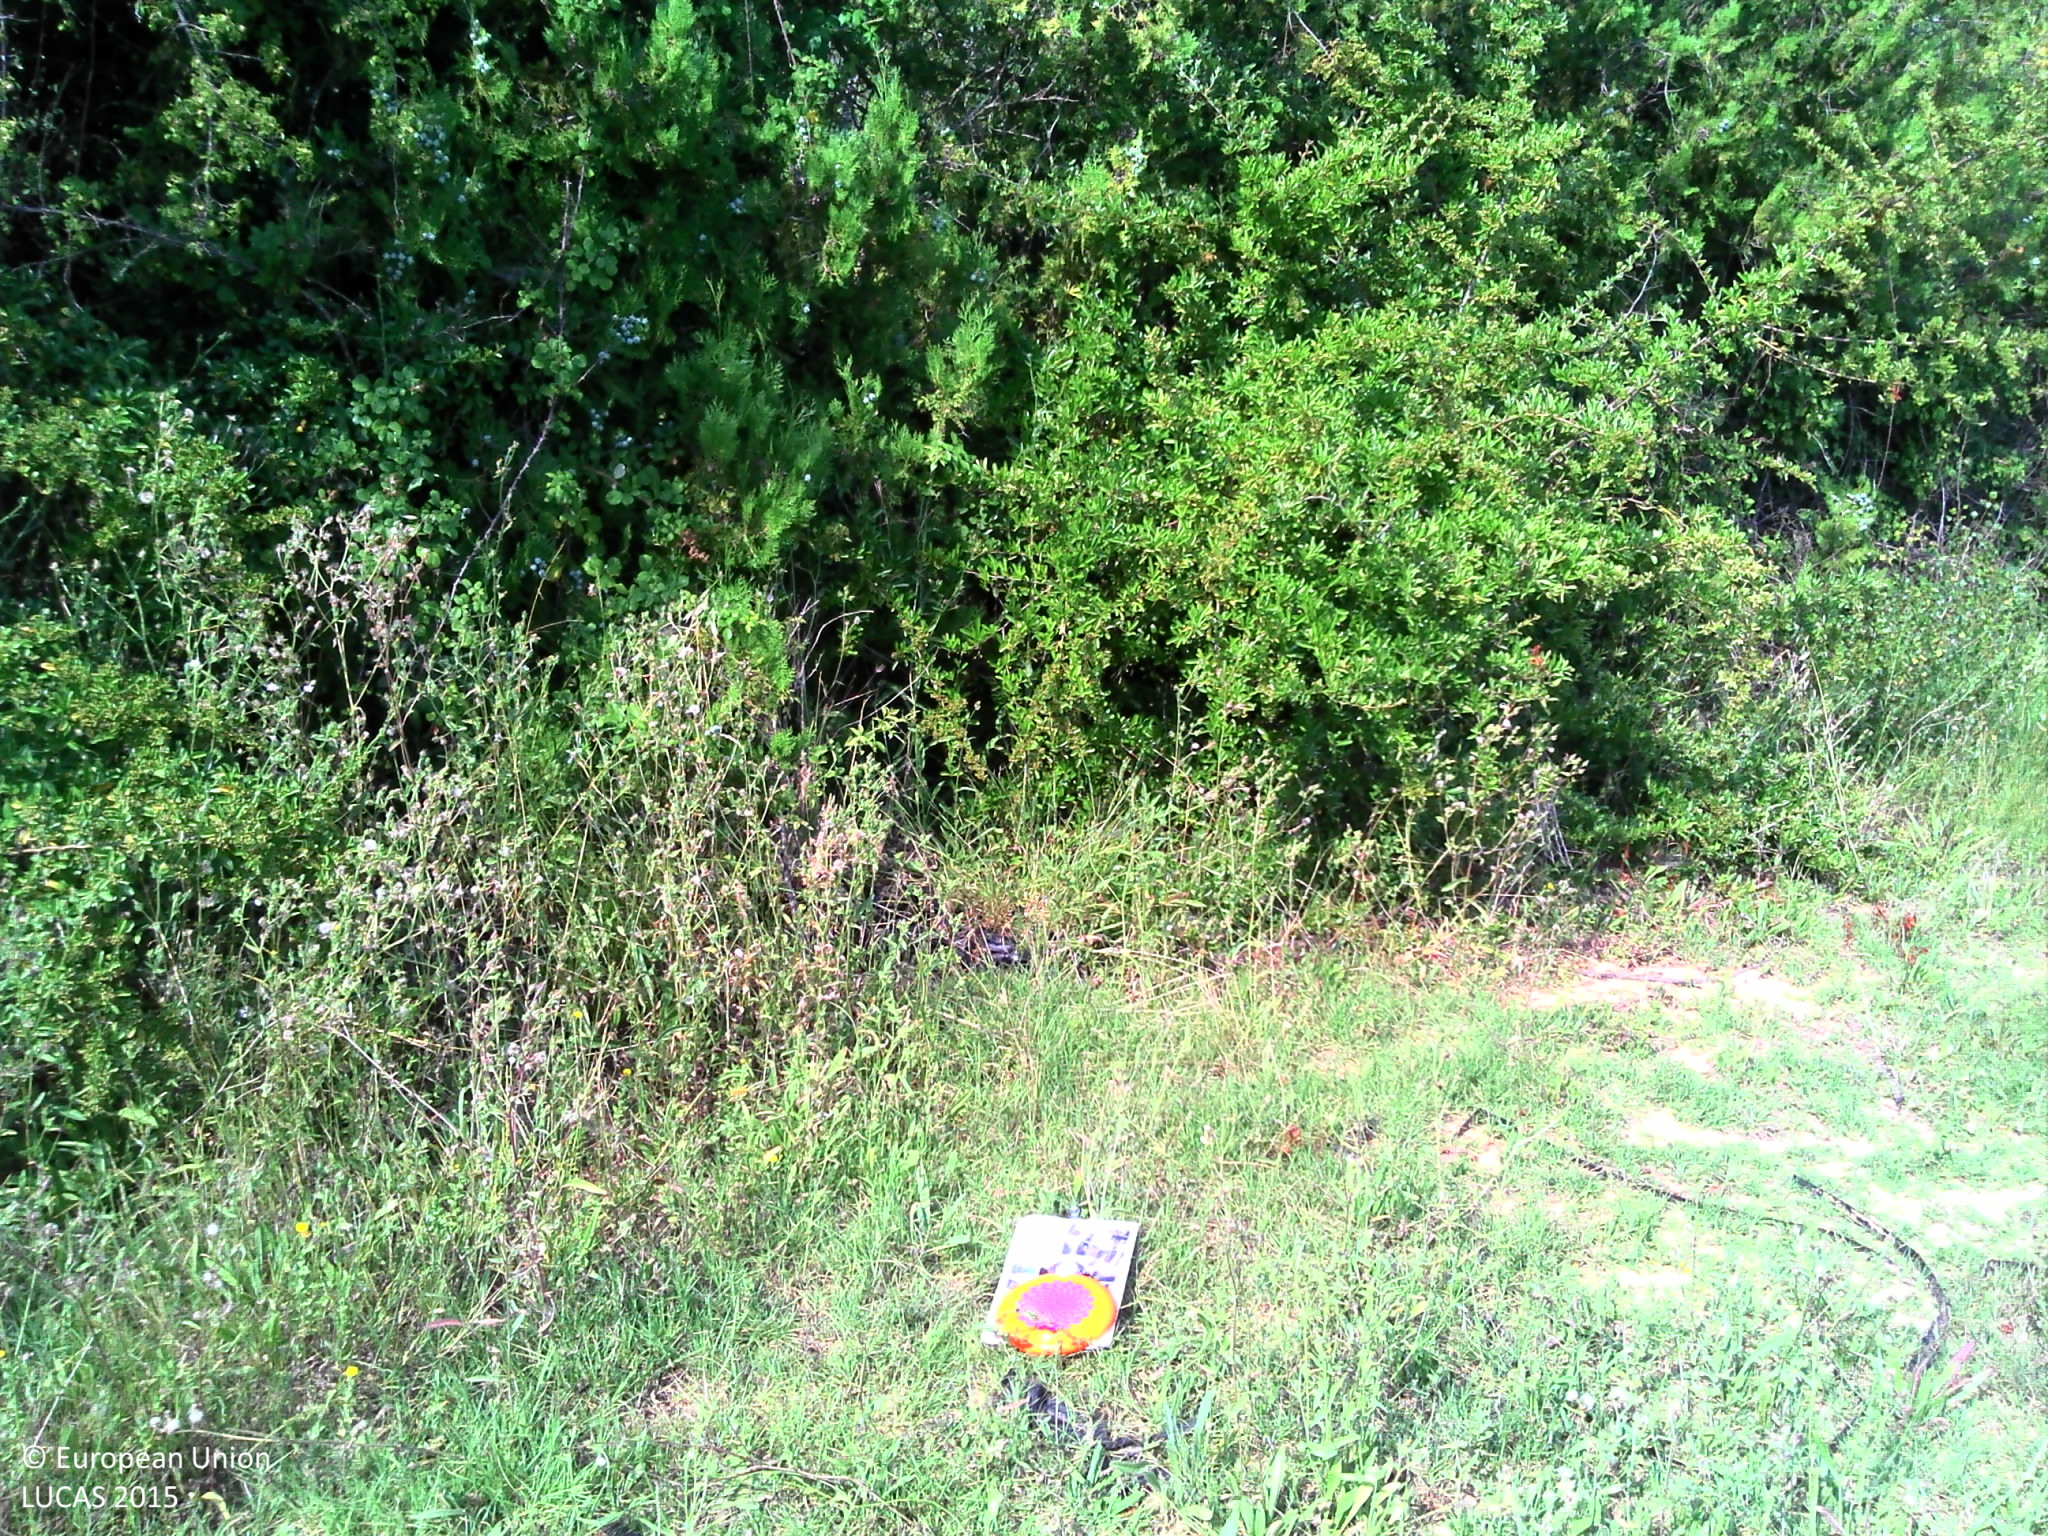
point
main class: Grassland
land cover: Grassland with sparse tree/shrub cover
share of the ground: > 75 %
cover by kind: herbaceous plants 75 %, shrubs 10 %, consolidated bare surface 10 %, broadleaved forest trees 5 %
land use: Residential
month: July
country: FR
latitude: 43.7885
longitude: 5.6221
